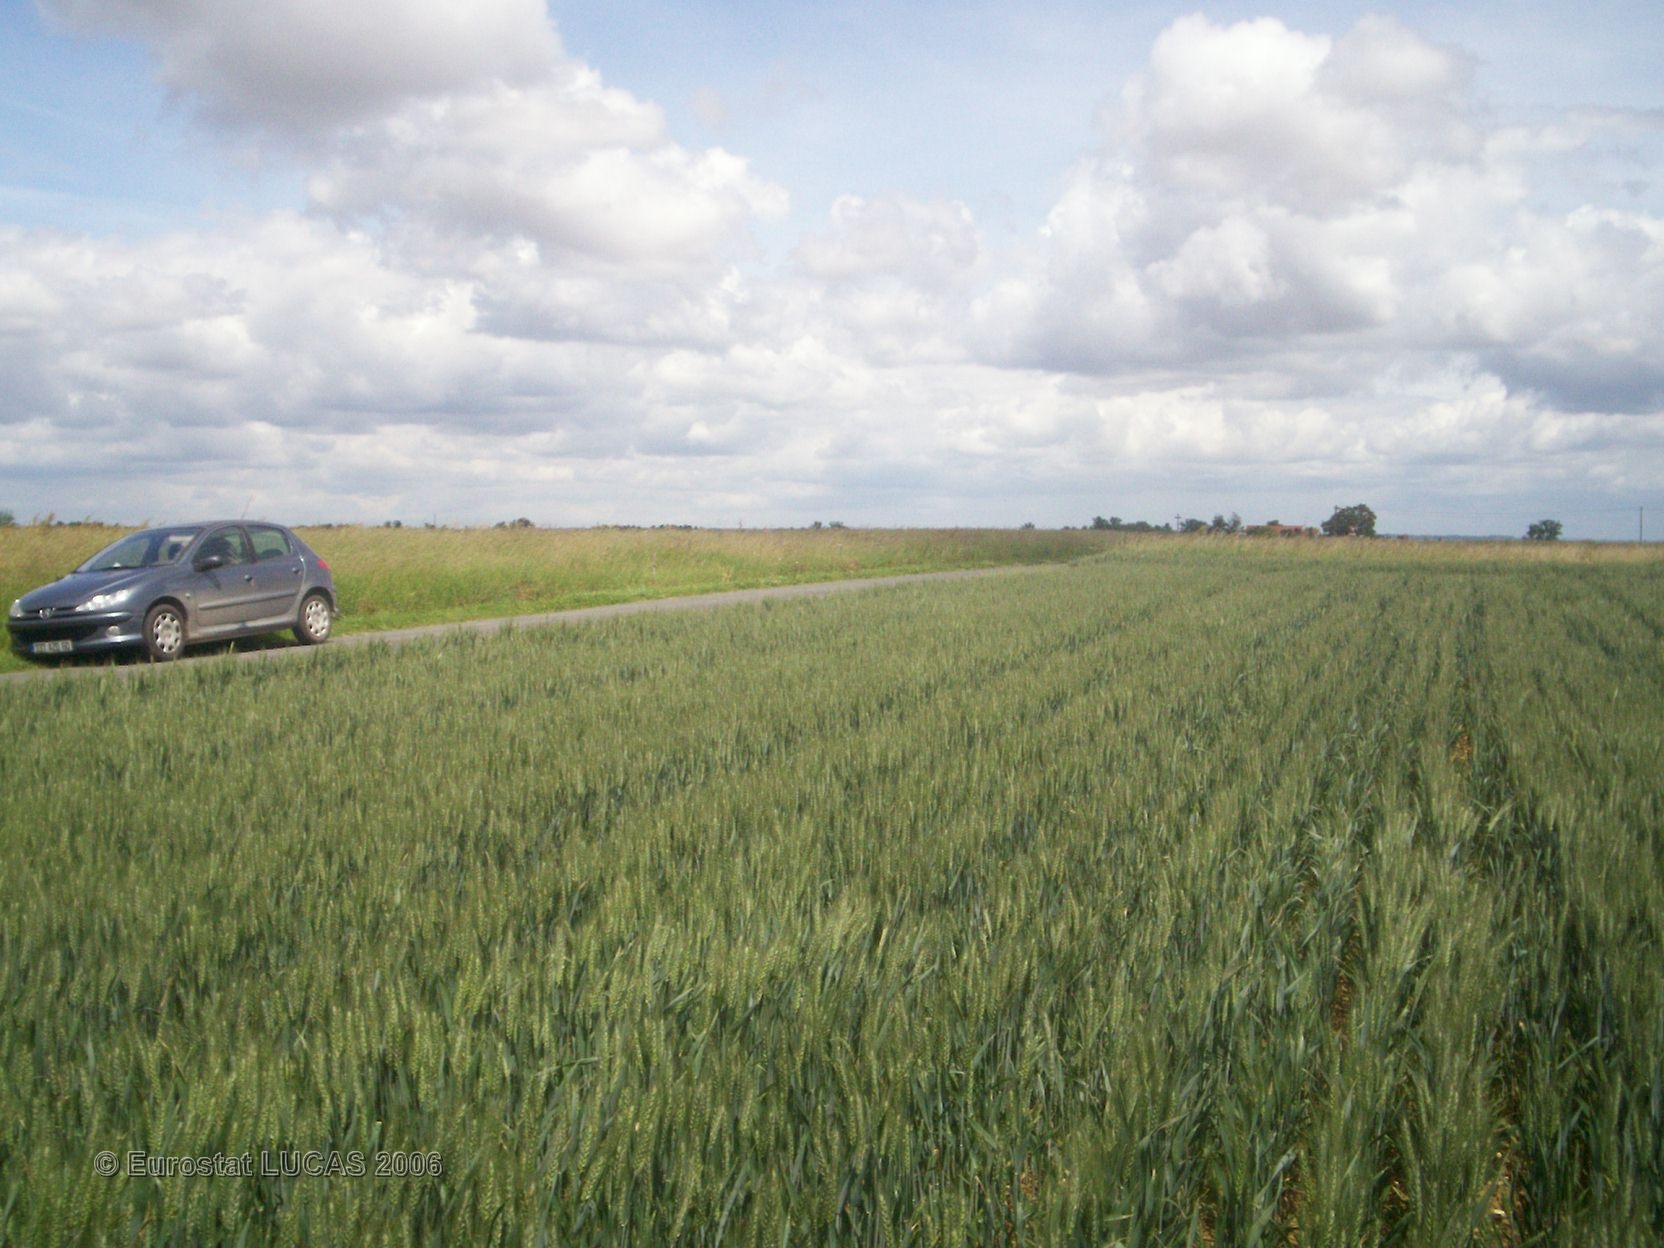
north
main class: Cropland
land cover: Common wheat
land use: Agriculture (excluding fallow land and kitchen gardens)
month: May
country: FR
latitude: 46.3884
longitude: -0.7567
